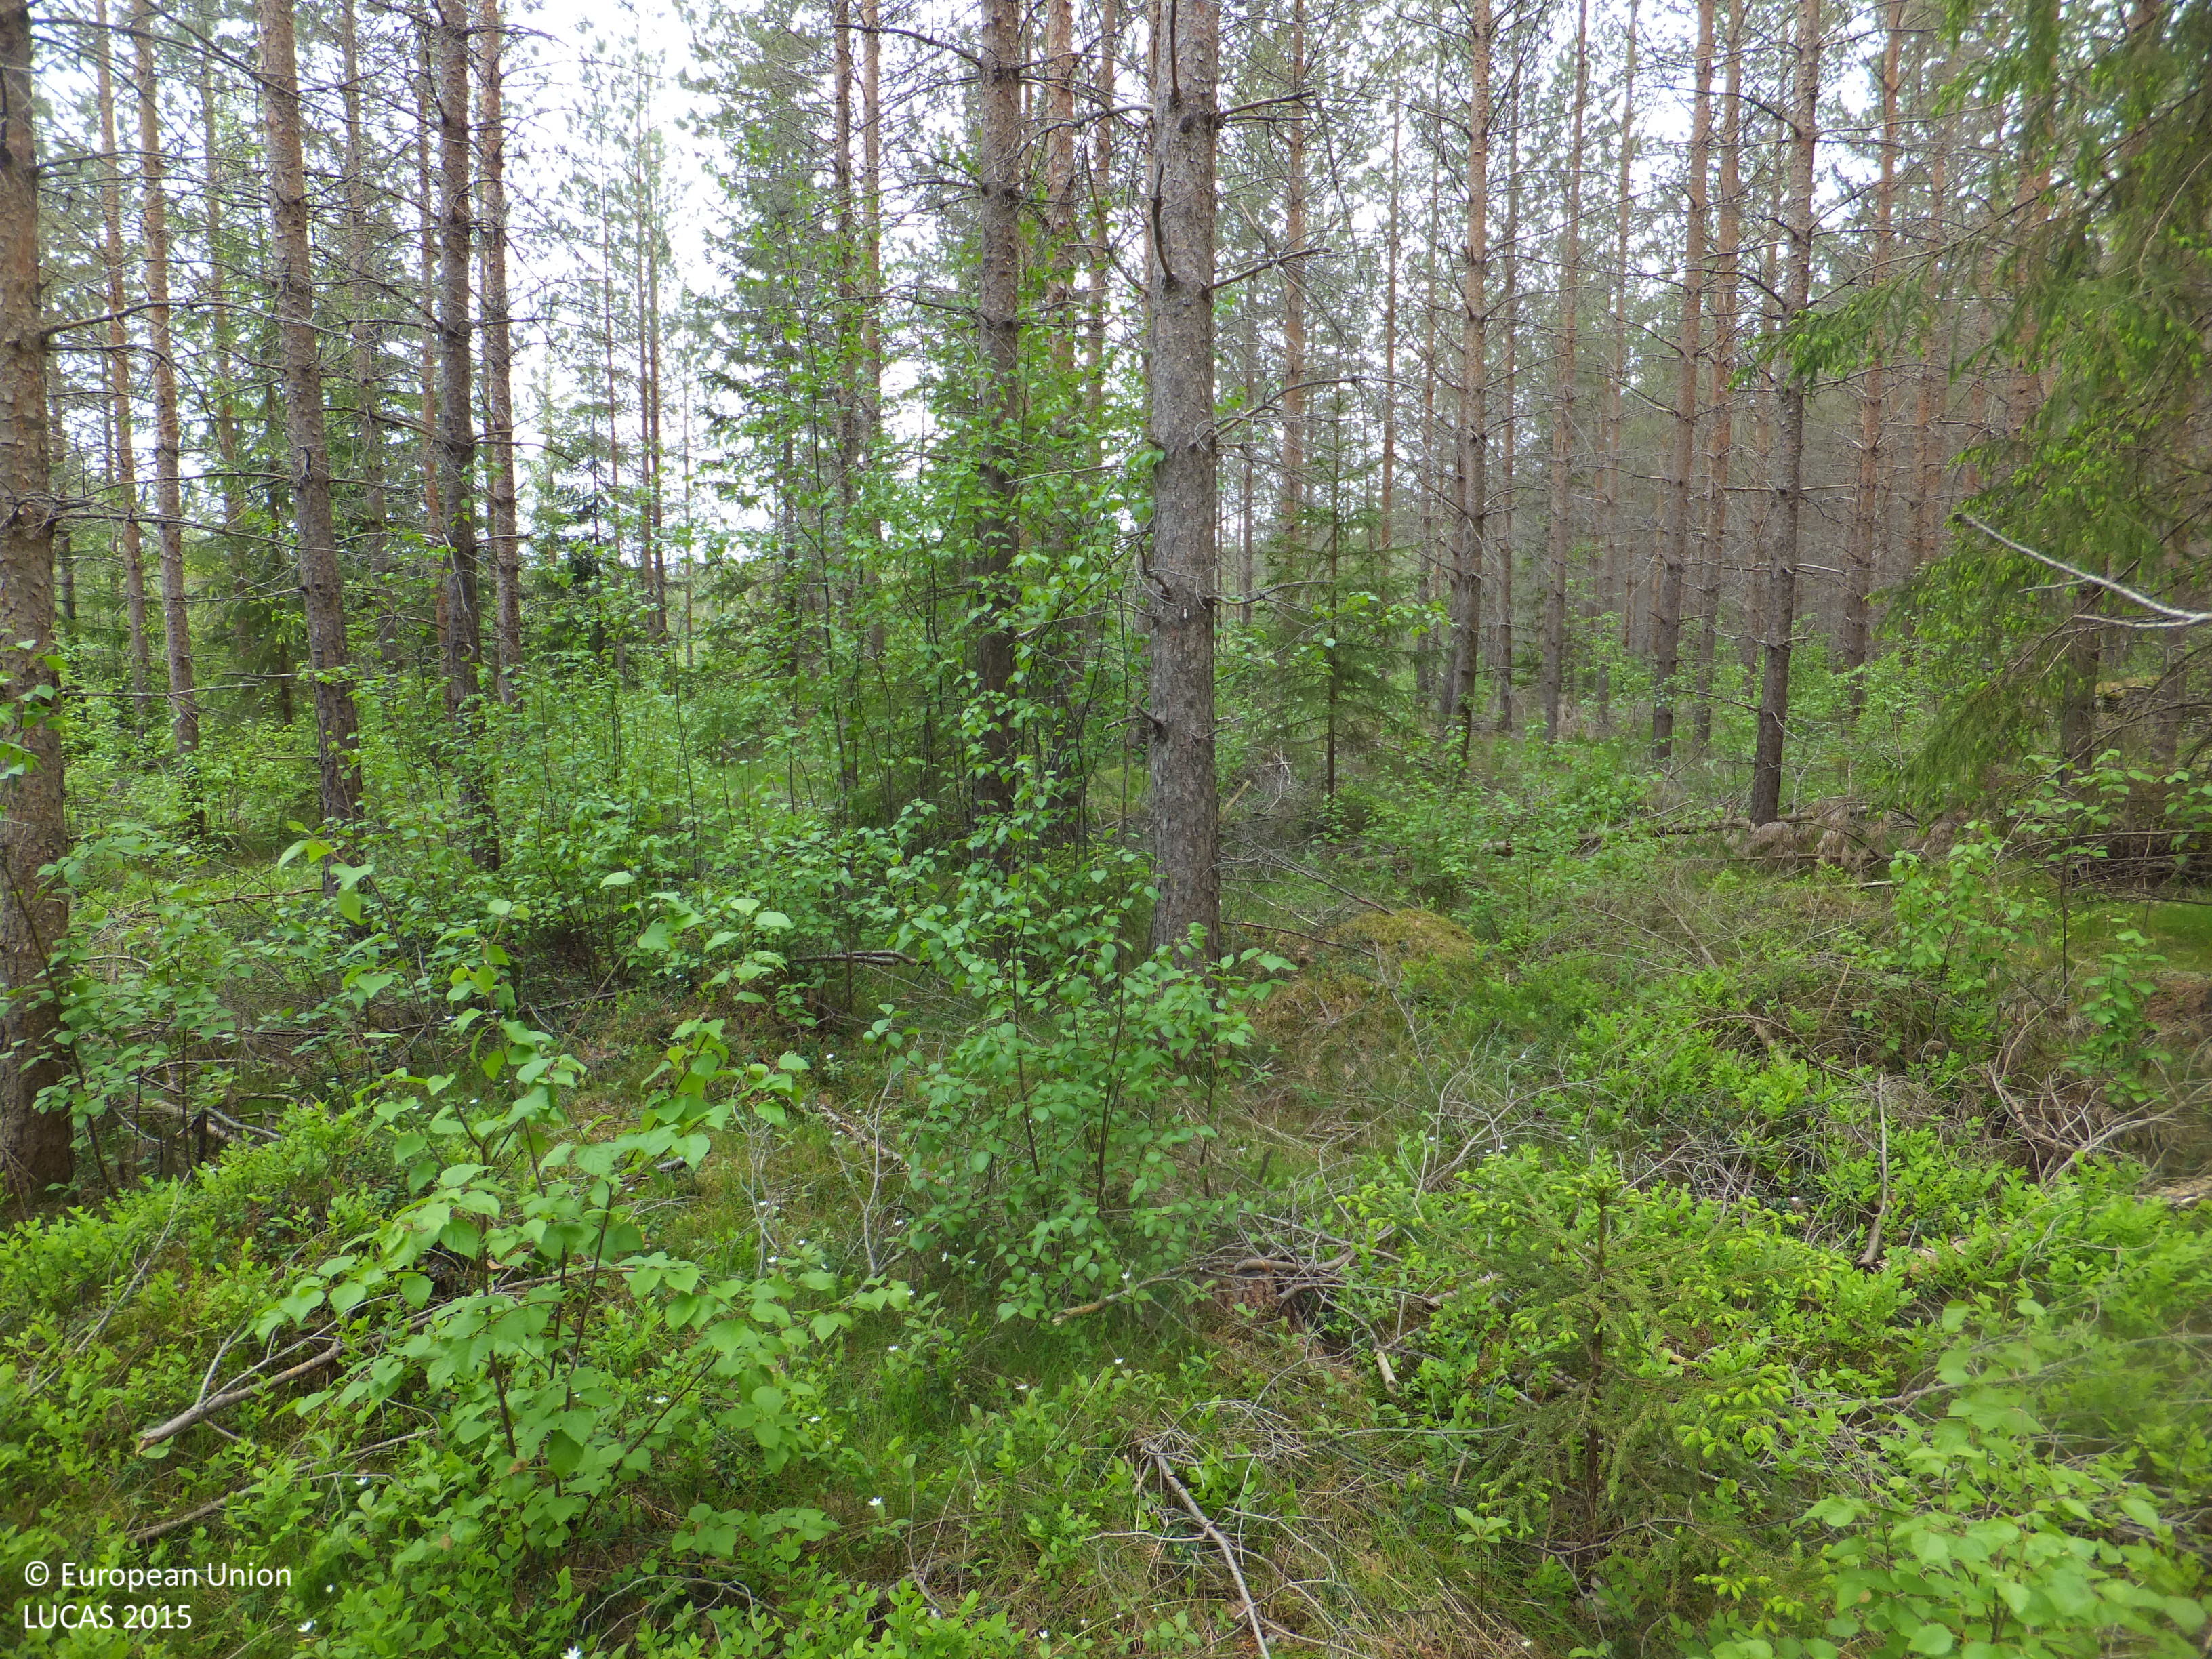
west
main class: Woodland
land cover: Pine dominated coniferous woodland
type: boreal forest
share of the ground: > 75 %
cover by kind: coniferous forest trees 80 %, broadleaved forest trees 5 %, shrubs 5 %, herbaceous plants 5 %, lichens and mosses 5 %
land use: Forestry
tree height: > 5 m
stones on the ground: 10 - 25 %
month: June
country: FI
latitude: 63.3329
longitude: 22.7337
